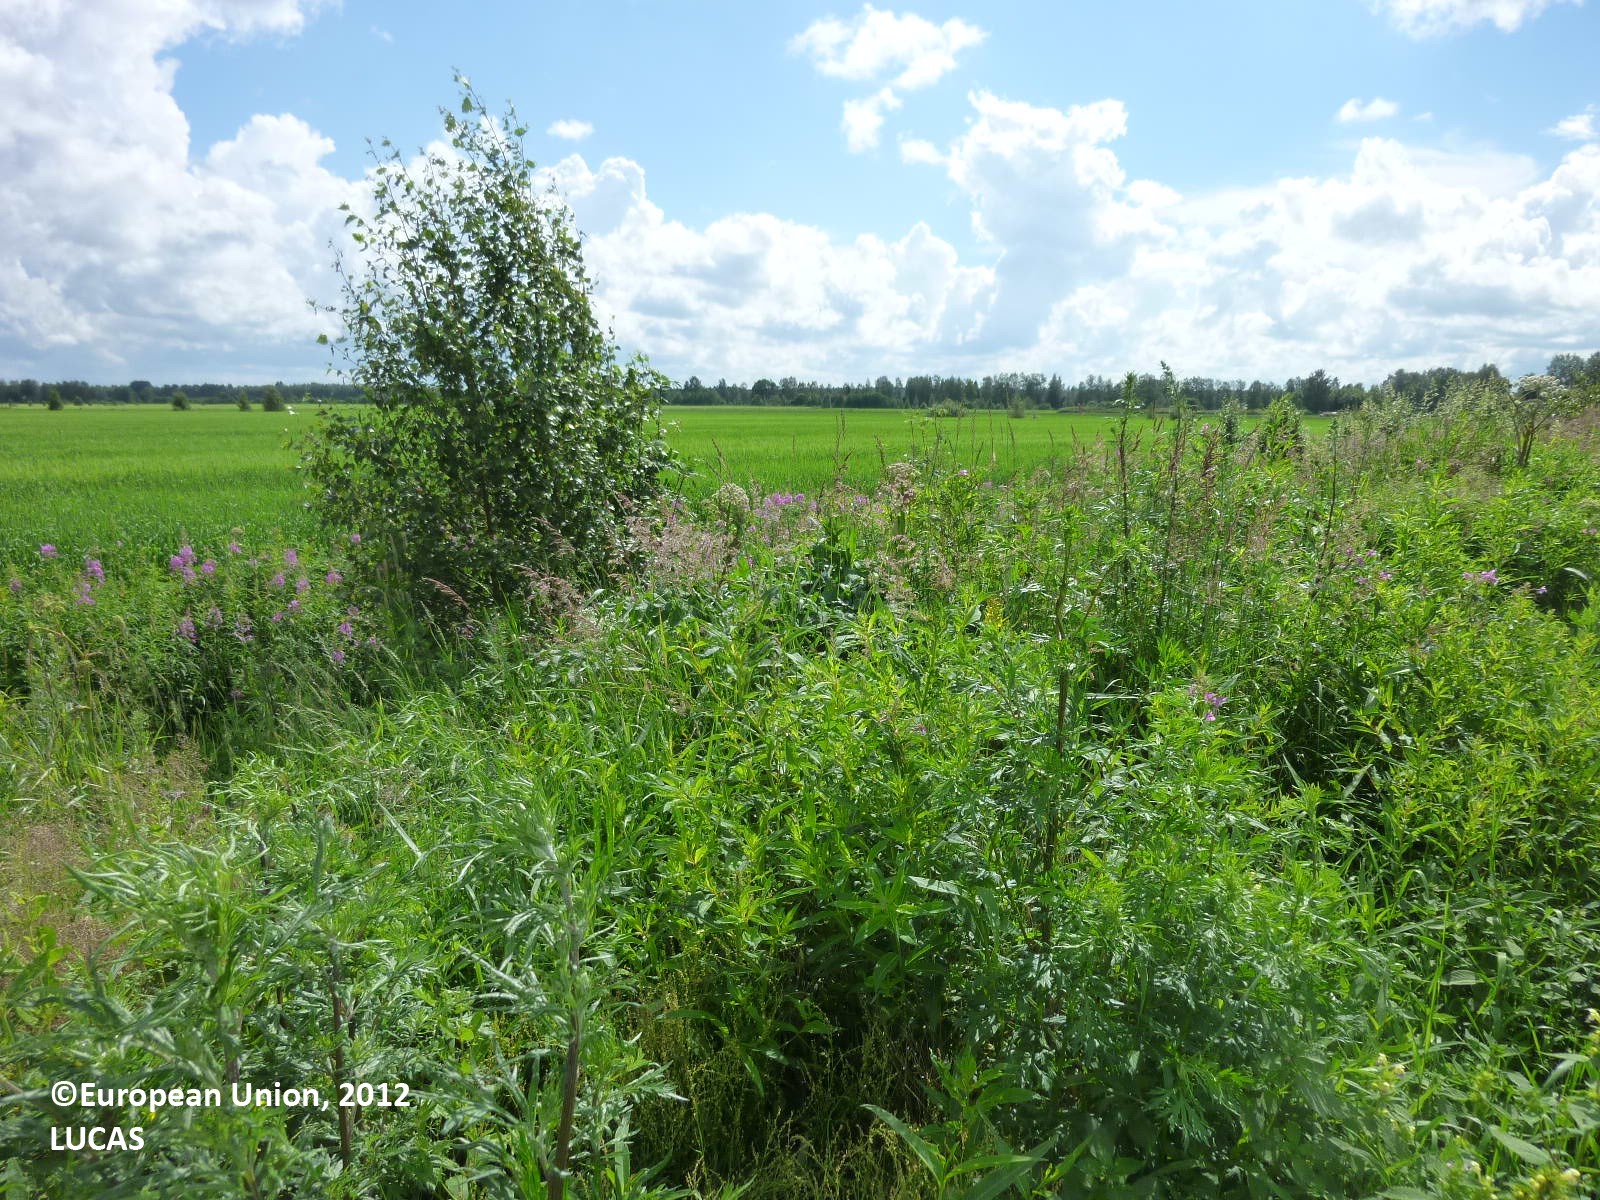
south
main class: Cropland
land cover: Barley
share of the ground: > 75 %
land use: Agriculture (excluding fallow land and kitchen gardens)
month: July
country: FI
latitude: 61.2239
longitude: 21.9196
